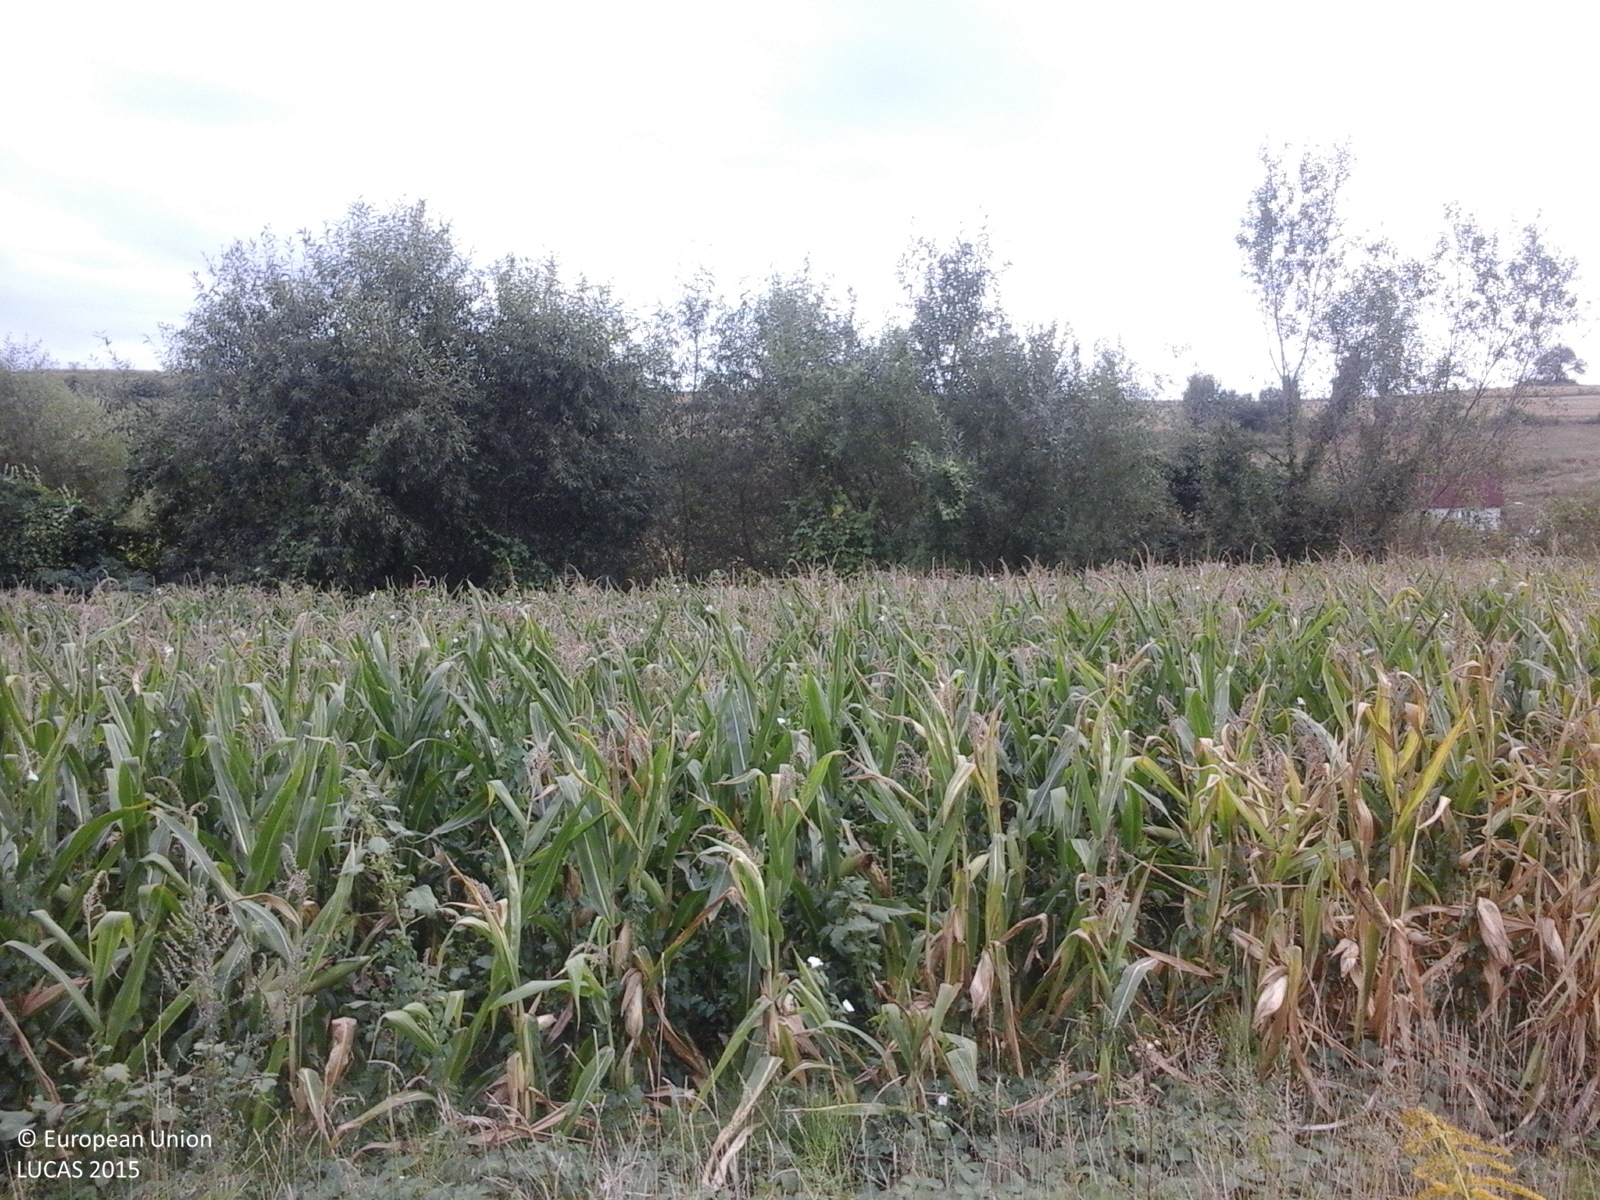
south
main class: Grassland
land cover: Spontaneously vegetated surfaces
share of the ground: > 75 %
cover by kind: herbaceous plants 100 %
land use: Fallow land
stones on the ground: < 10 %
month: September
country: RO
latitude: 47.4939
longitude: 23.0880
